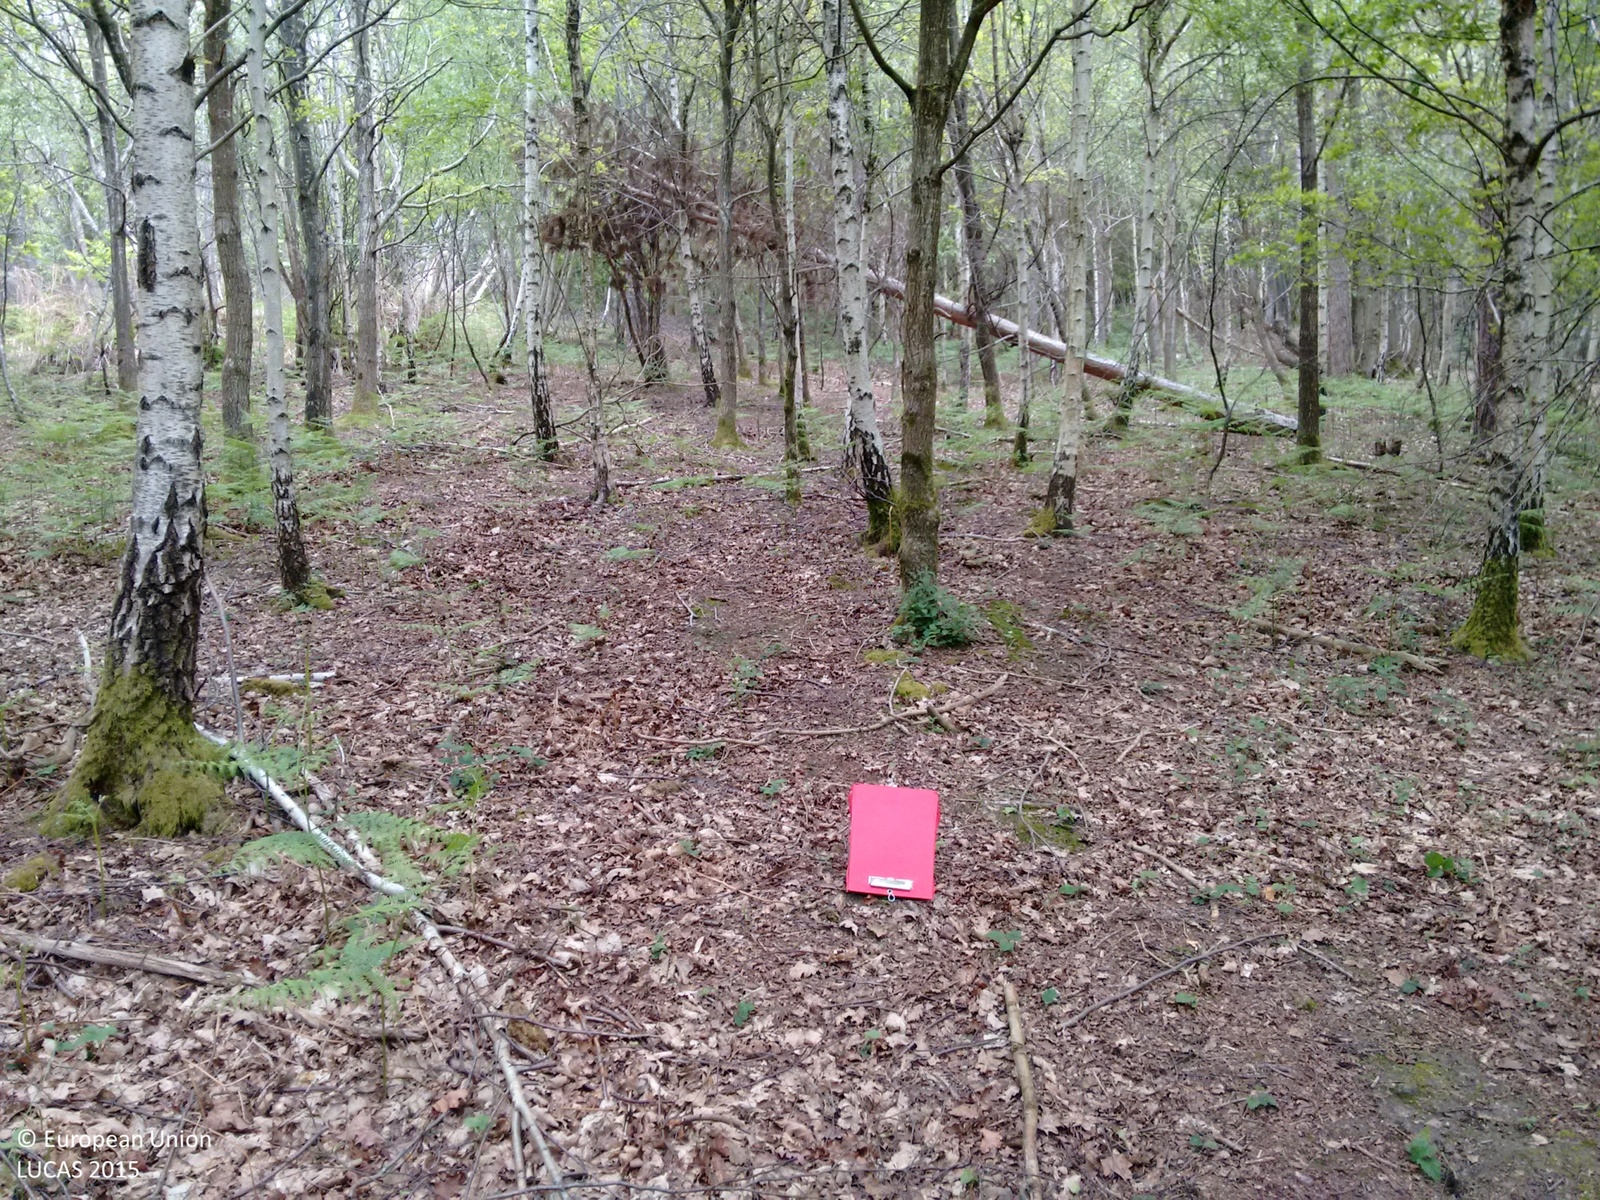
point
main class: Woodland
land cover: Broadleaved woodland
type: mesophytic deciduous forest
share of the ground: > 75 %
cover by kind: broadleaved forest trees 95 %, coniferous forest trees 5 %
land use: Forestry
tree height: > 5 m
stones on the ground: < 10 %
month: May
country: GB
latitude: 51.1125
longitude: 0.3286
